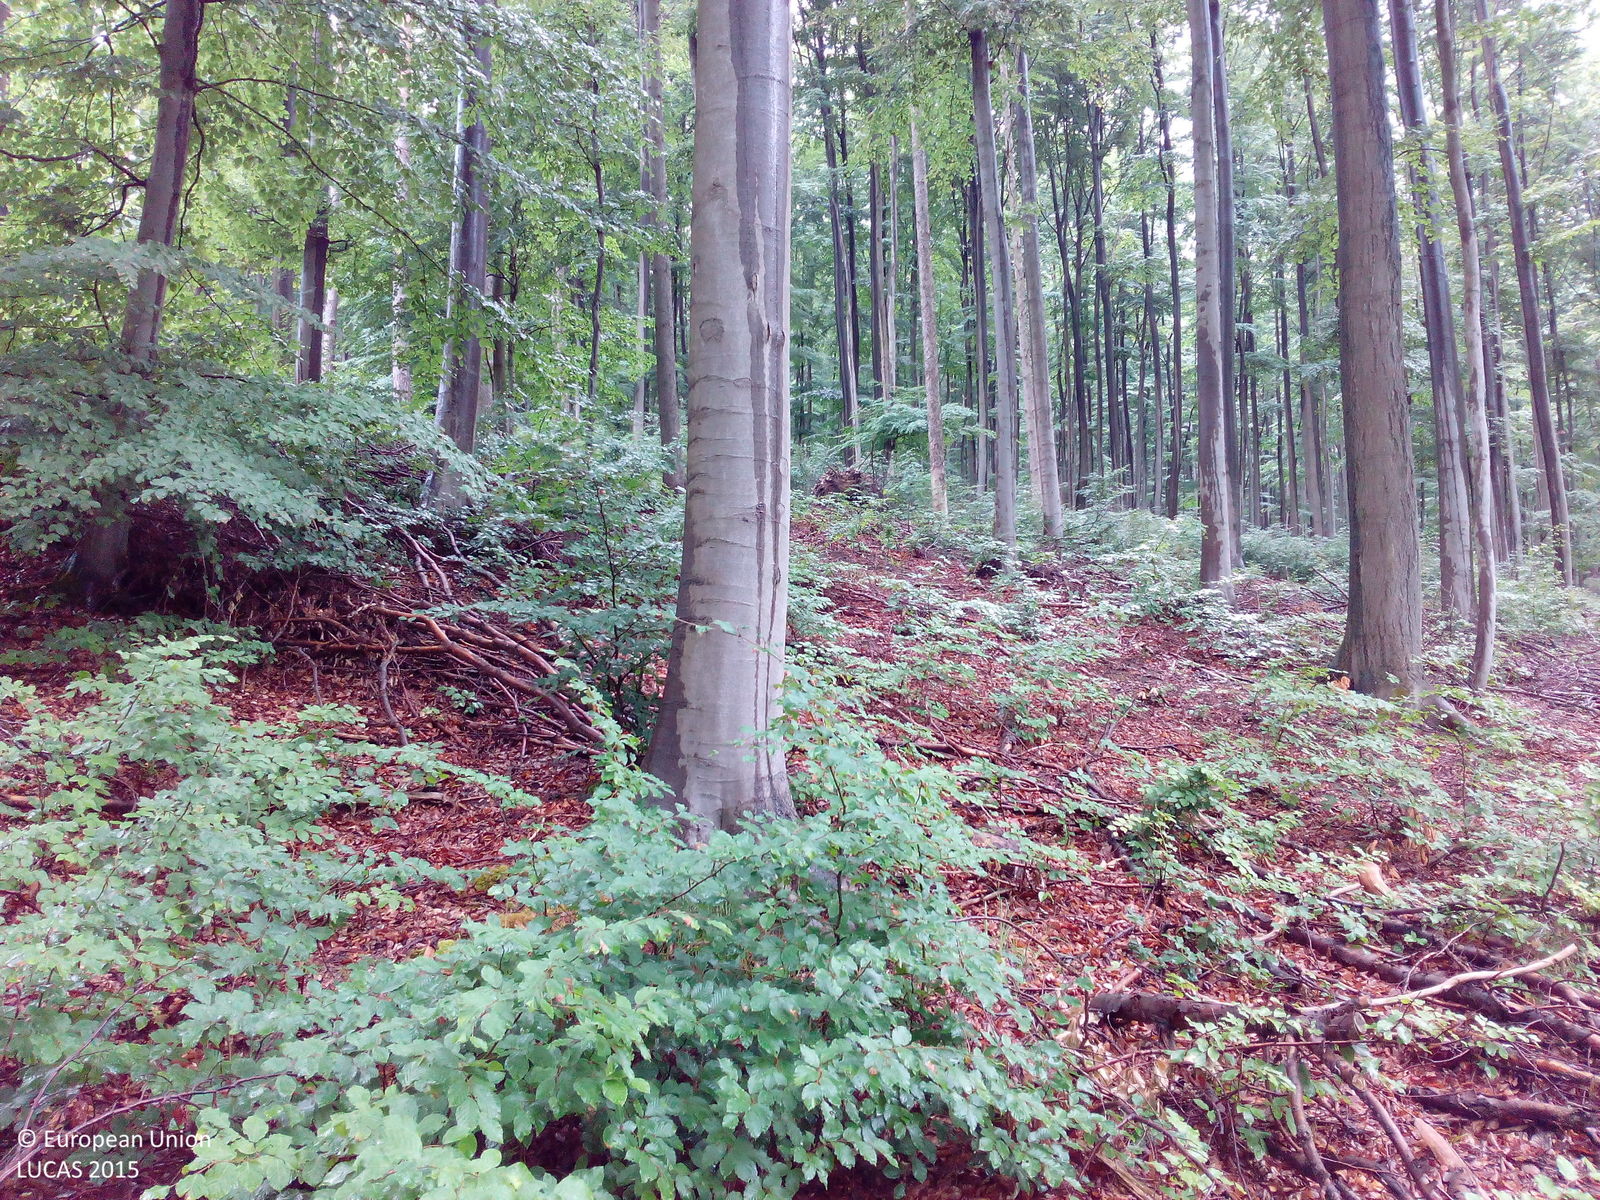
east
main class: Woodland
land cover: Broadleaved woodland
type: beech forest
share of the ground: > 75 %
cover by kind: broadleaved forest trees 90 %, herbaceous plants 10 %
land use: Forestry
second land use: Amenities, museums, leisure
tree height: > 5 m
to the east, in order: Broadleaved woodland; Tracks; Broadleaved woodland; Tracks; Broadleaved woodland
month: June
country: DE
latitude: 51.9640
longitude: 9.8691
